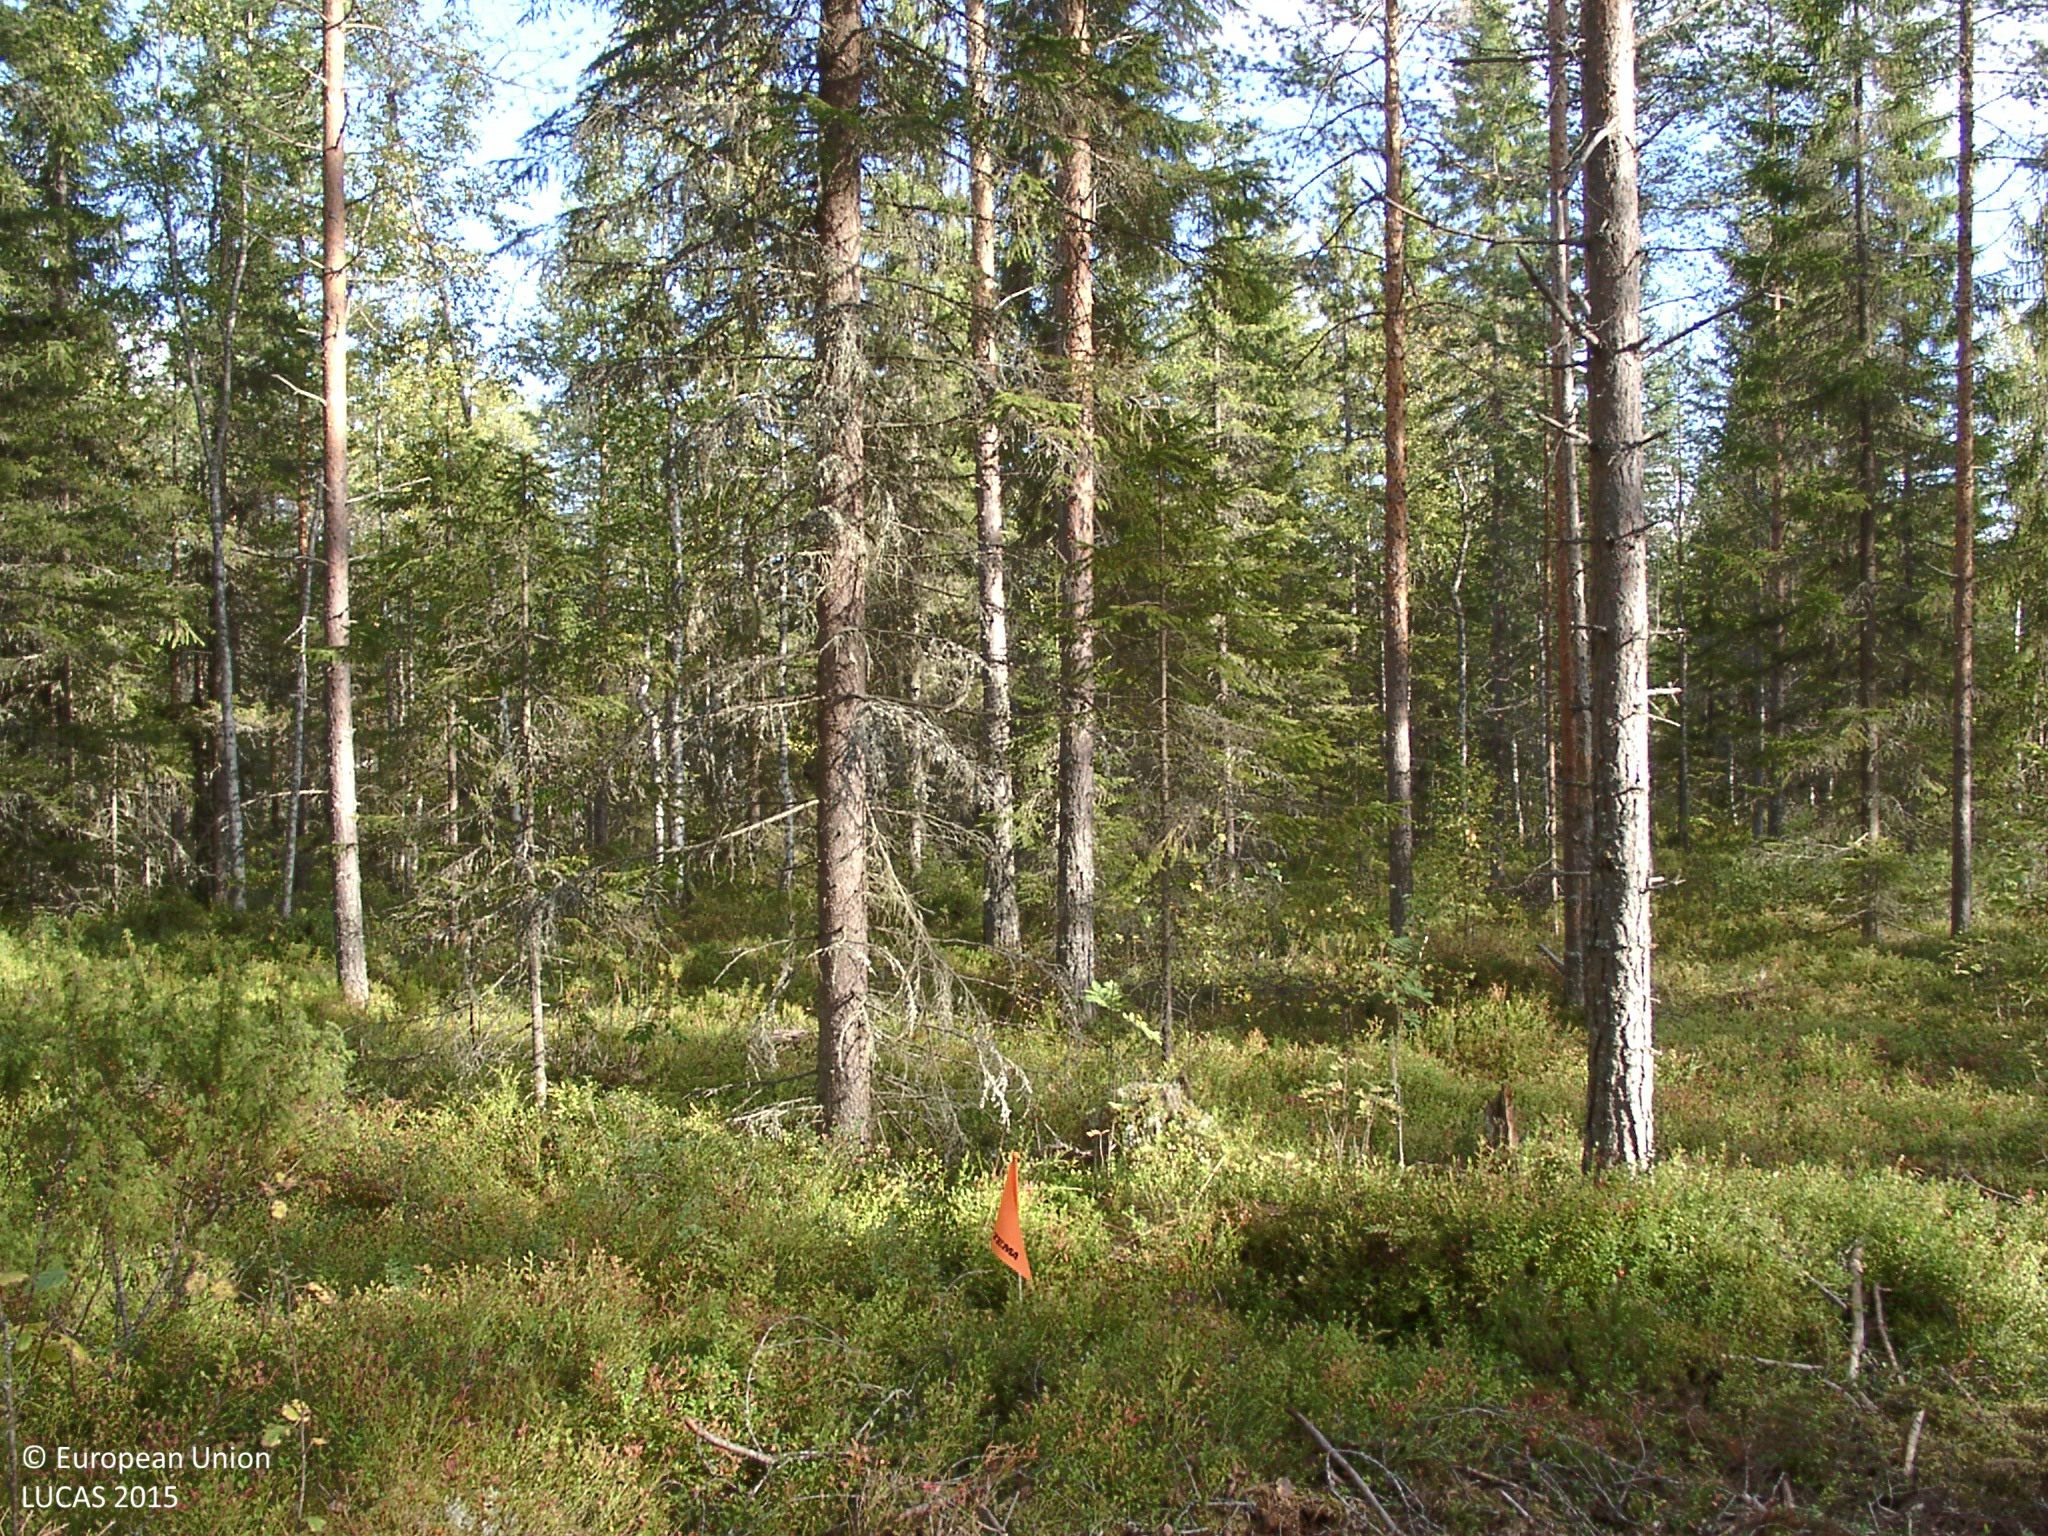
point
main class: Woodland
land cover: Other coniferous woodland
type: boreal forest
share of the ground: 50 - 75 %
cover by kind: coniferous forest trees 55 %, shrubs 35 %, lichens and mosses 10 %
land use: Forestry
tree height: > 5 m
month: September
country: FI
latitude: 62.7109
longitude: 25.0957
